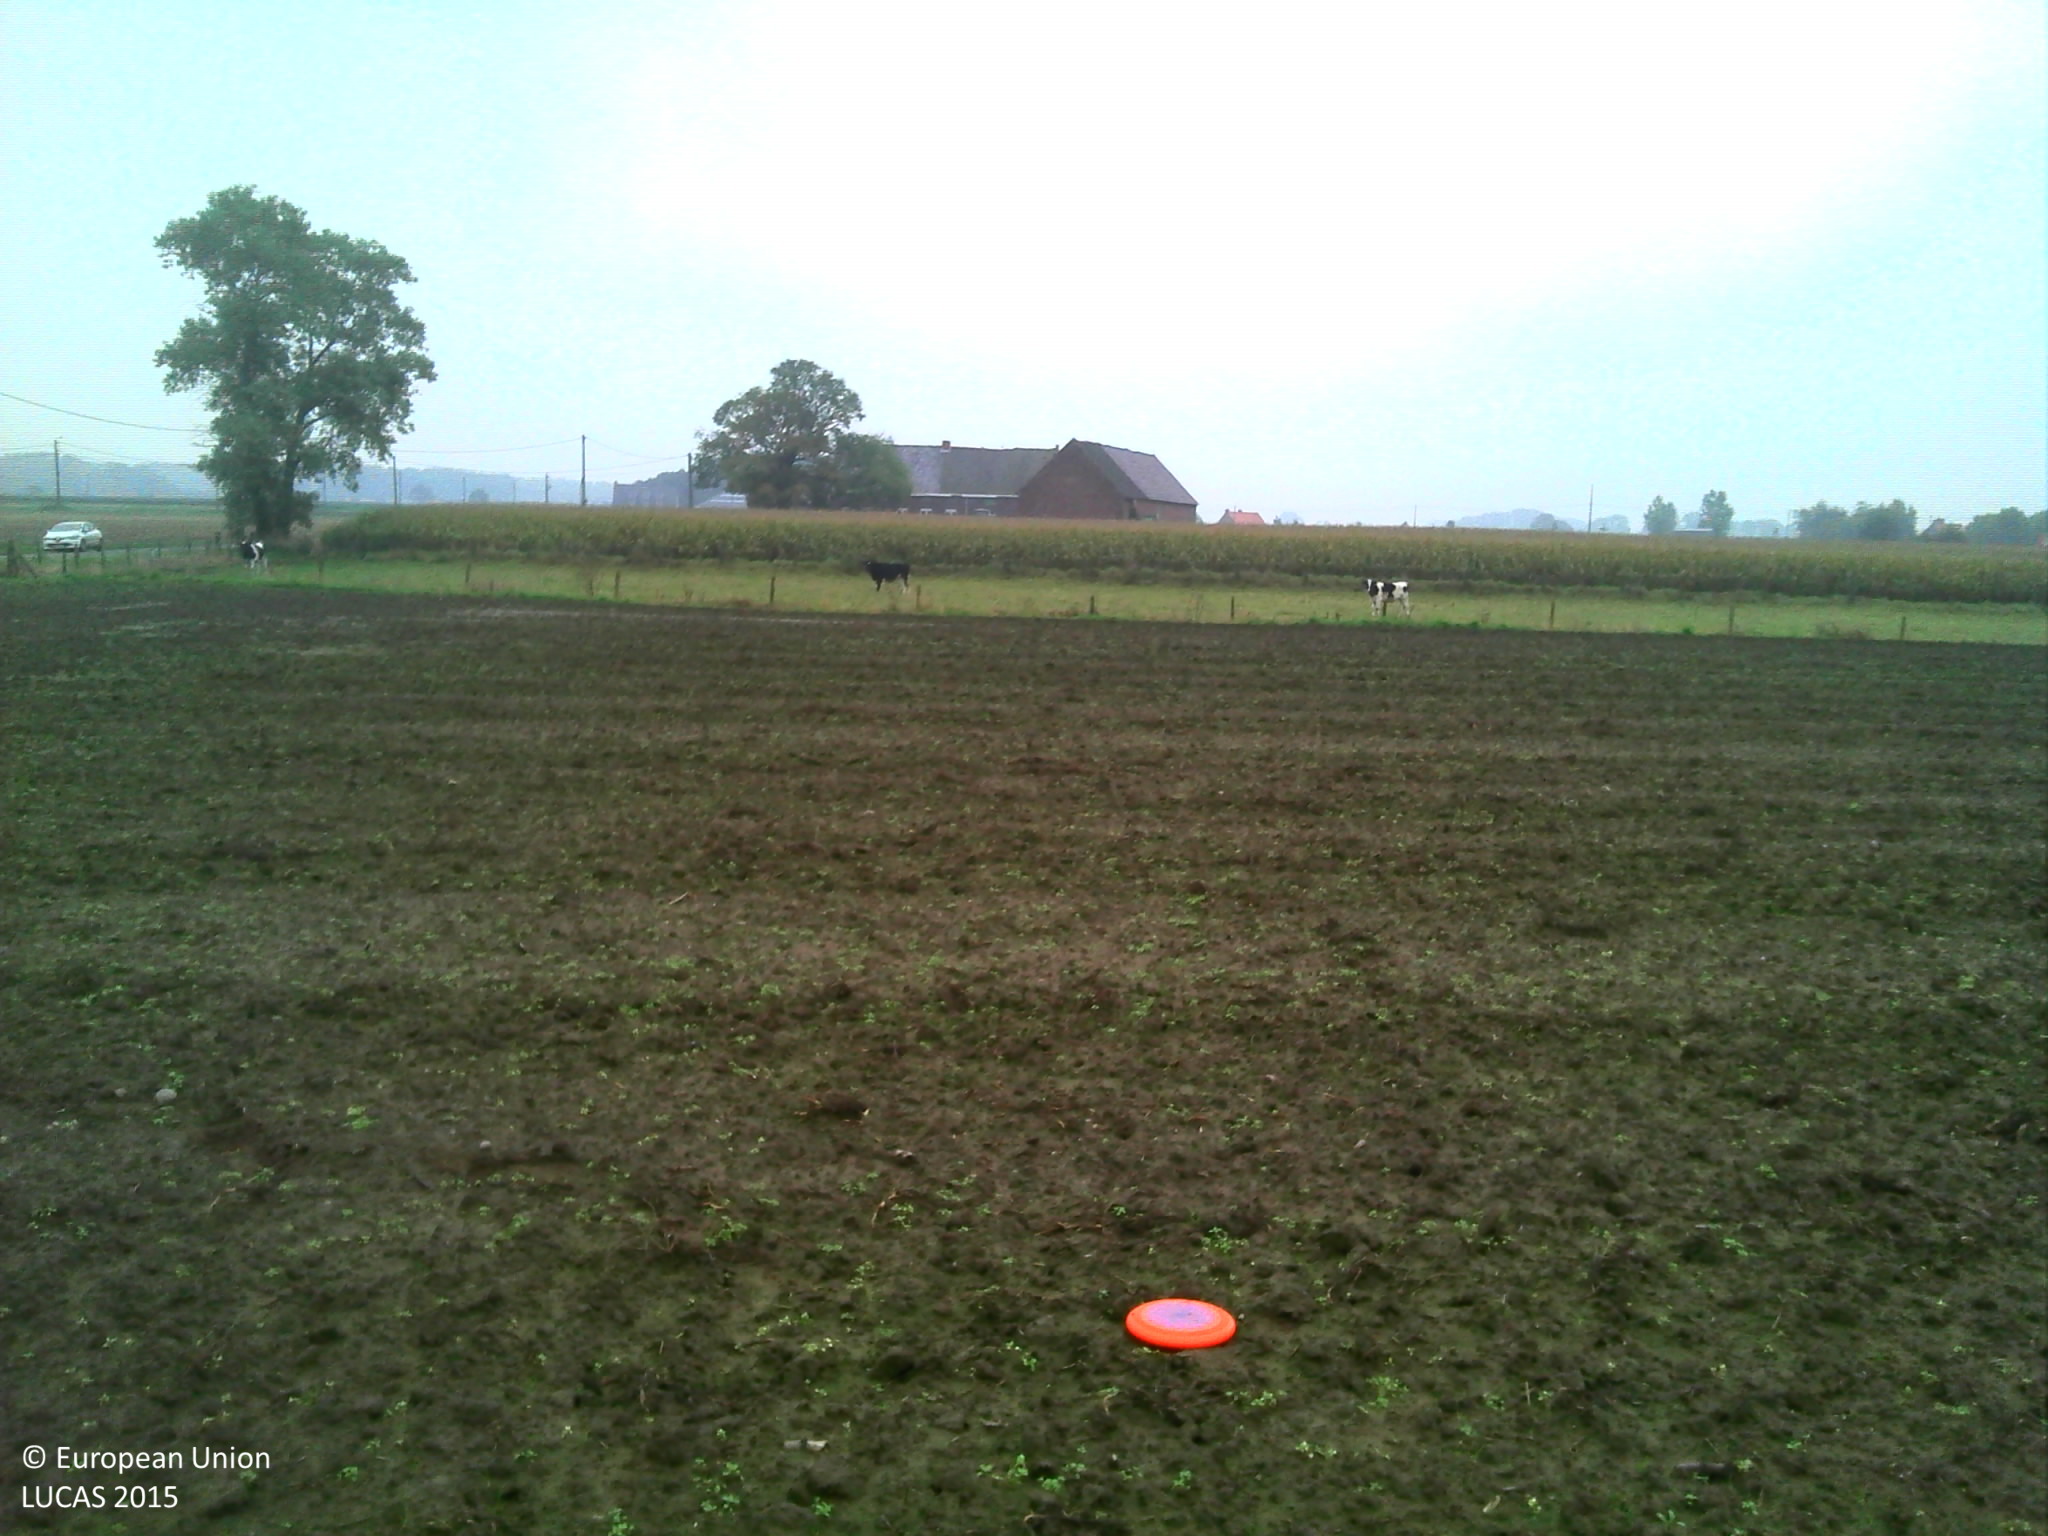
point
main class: Grassland
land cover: Spontaneously vegetated surfaces
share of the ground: 10 - 25 %
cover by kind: unconsolidated bare surface 85 %, herbaceous plants 15 %
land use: Agriculture (excluding fallow land and kitchen gardens)
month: October
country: BE
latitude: 51.0545
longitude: 3.0423
